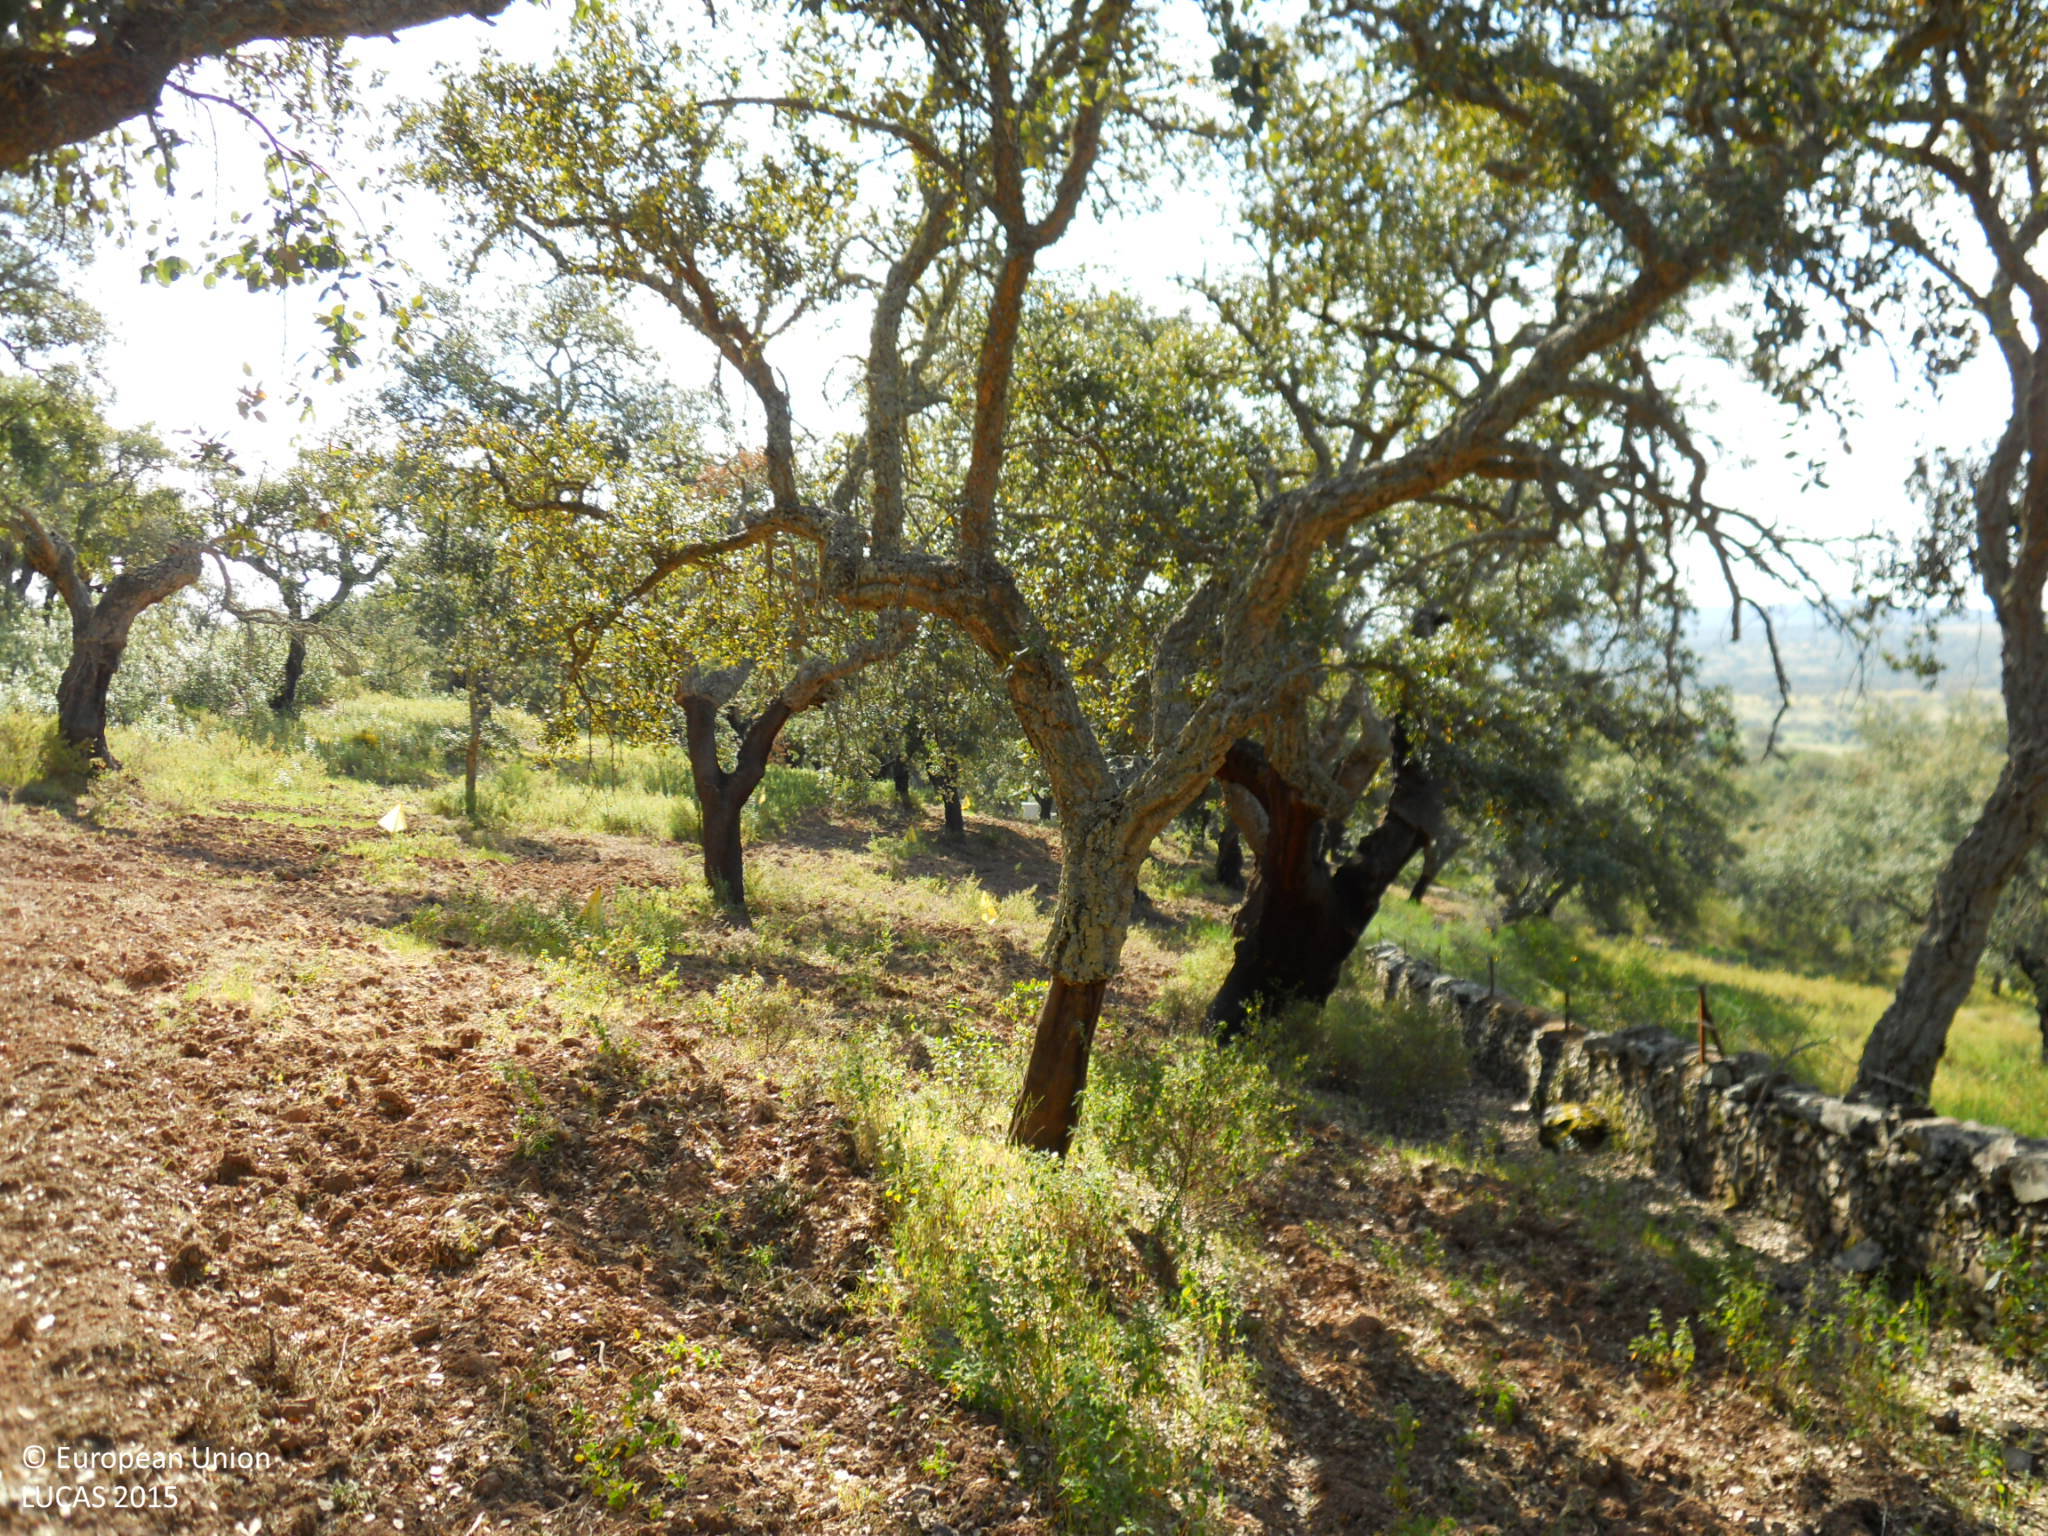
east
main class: Woodland
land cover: Broadleaved woodland
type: broadleaved evergreen forest
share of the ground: > 75 %
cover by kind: broadleaved forest trees 90 %, unconsolidated bare surface 10 %
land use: Forestry
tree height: > 5 m
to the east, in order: Broadleaved woodland; Other bare soil; Tracks; Broadleaved woodland
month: April
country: ES
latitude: 39.2049
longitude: -6.9476
